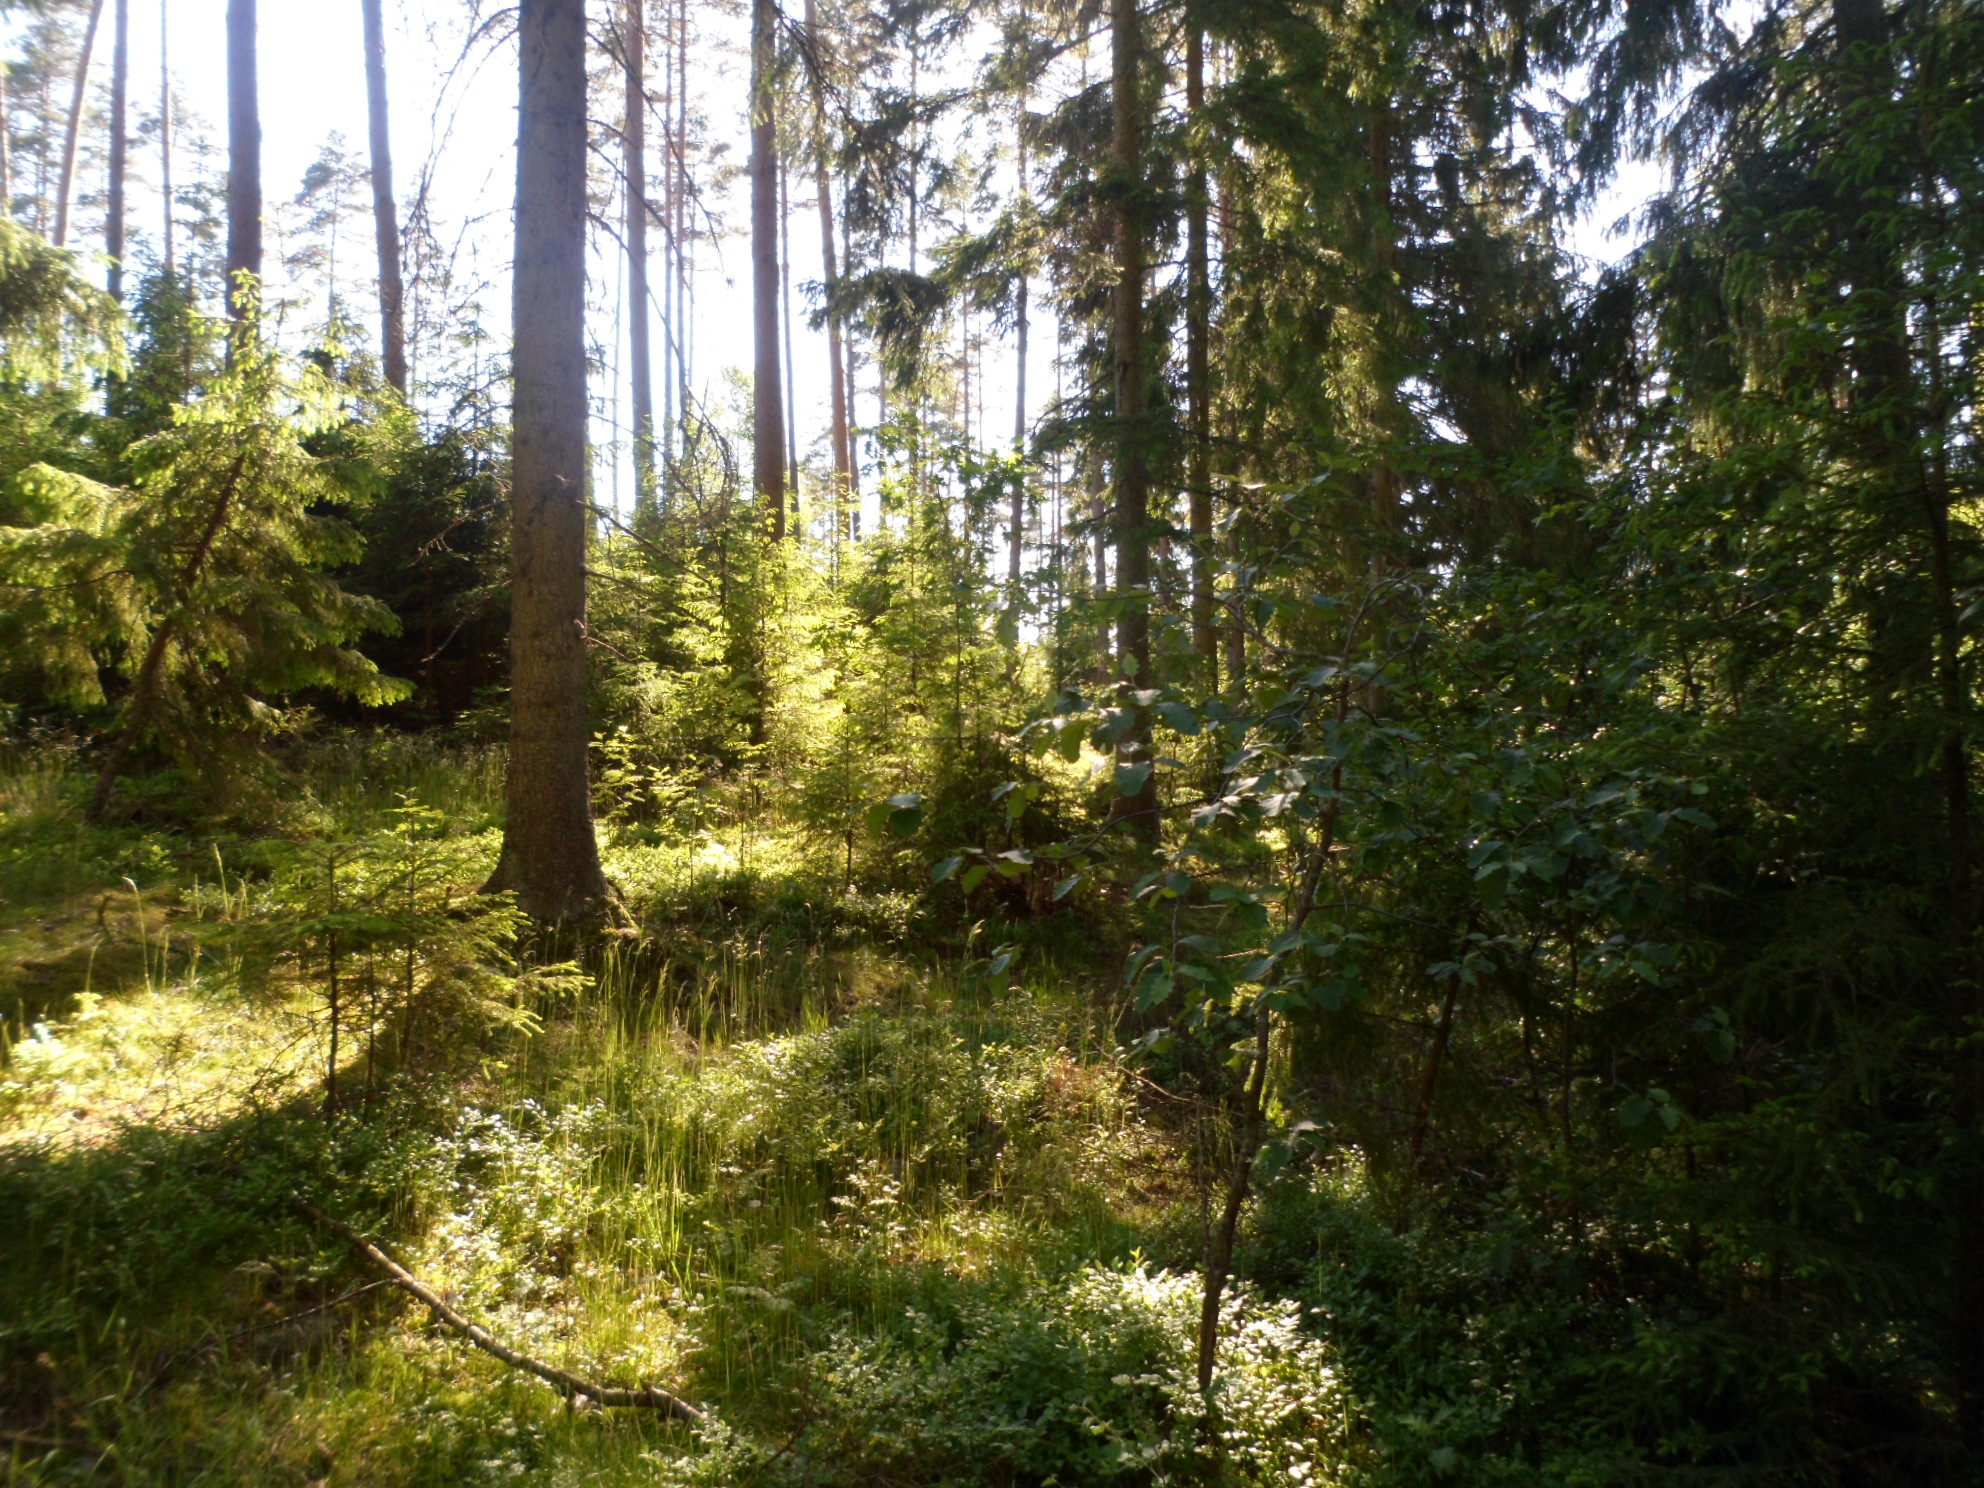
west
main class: Woodland
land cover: Spruce dominated coniferous woodland
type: boreal forest
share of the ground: 50 - 75 %
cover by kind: coniferous forest trees 55 %, shrubs 20 %, broadleaved forest trees 10 %, lichens and mosses 10 %, herbaceous plants 5 %
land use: Forestry
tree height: > 5 m
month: July
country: SE
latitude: 57.4331
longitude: 14.7431
